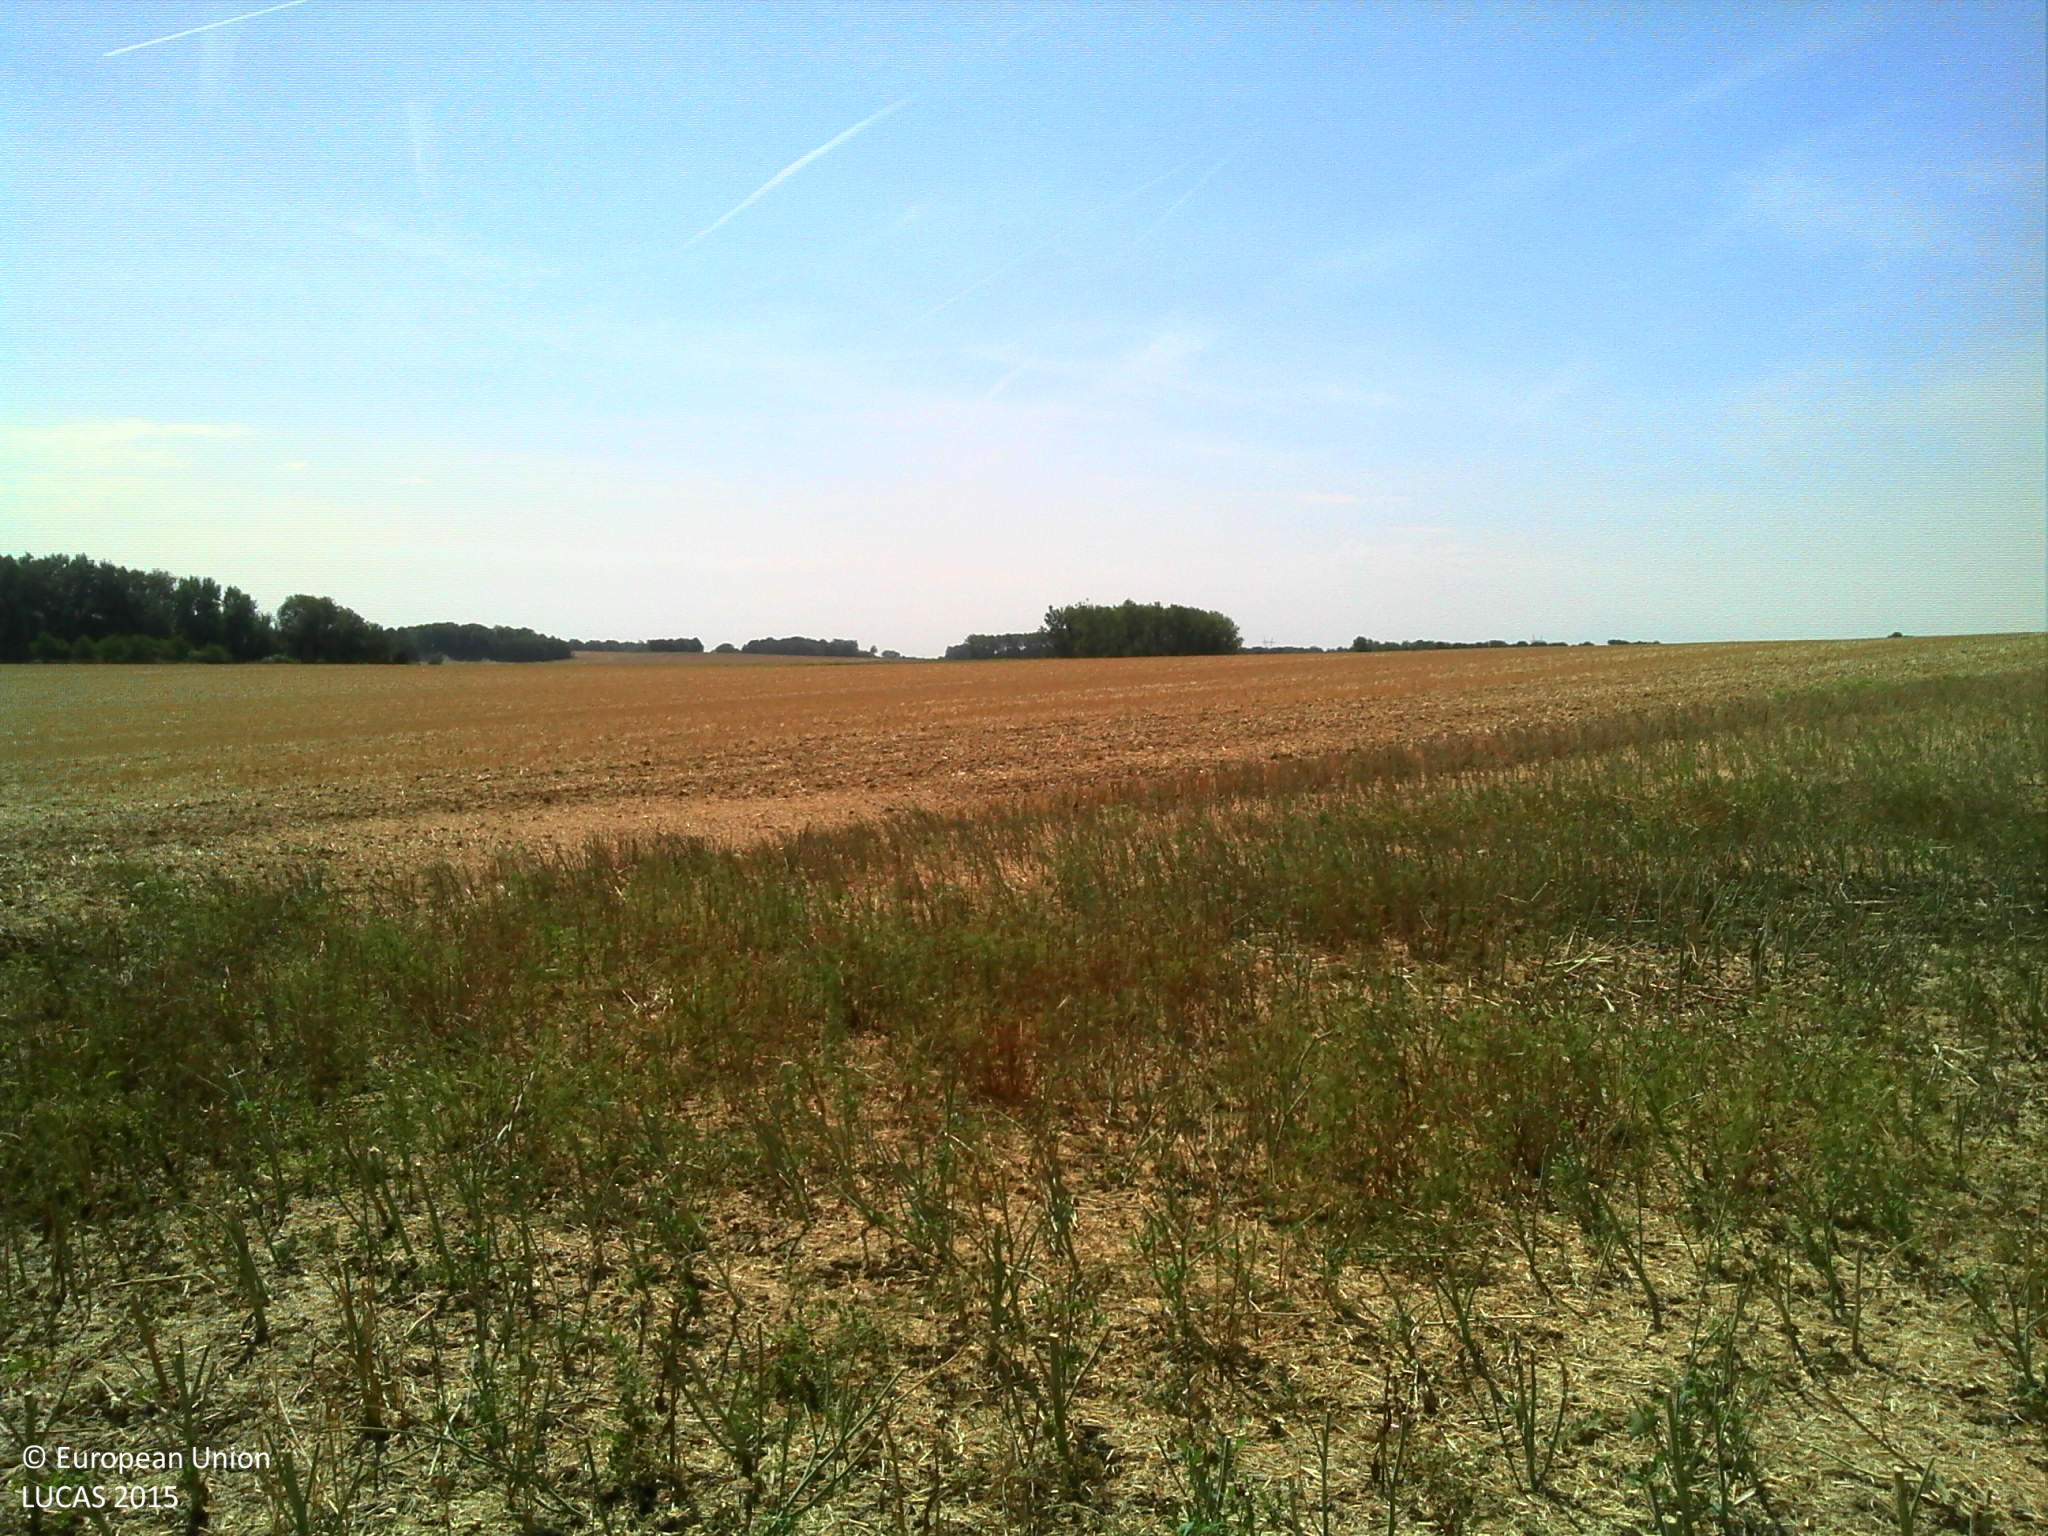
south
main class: Grassland
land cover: Grassland with sparse tree/shrub cover
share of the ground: > 75 %
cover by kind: herbaceous plants 85 %, broadleaved forest trees 5 %, consolidated bare surface 5 %
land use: Residential
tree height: < 5 m
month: August
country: FR
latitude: 48.8502
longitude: 3.3013
